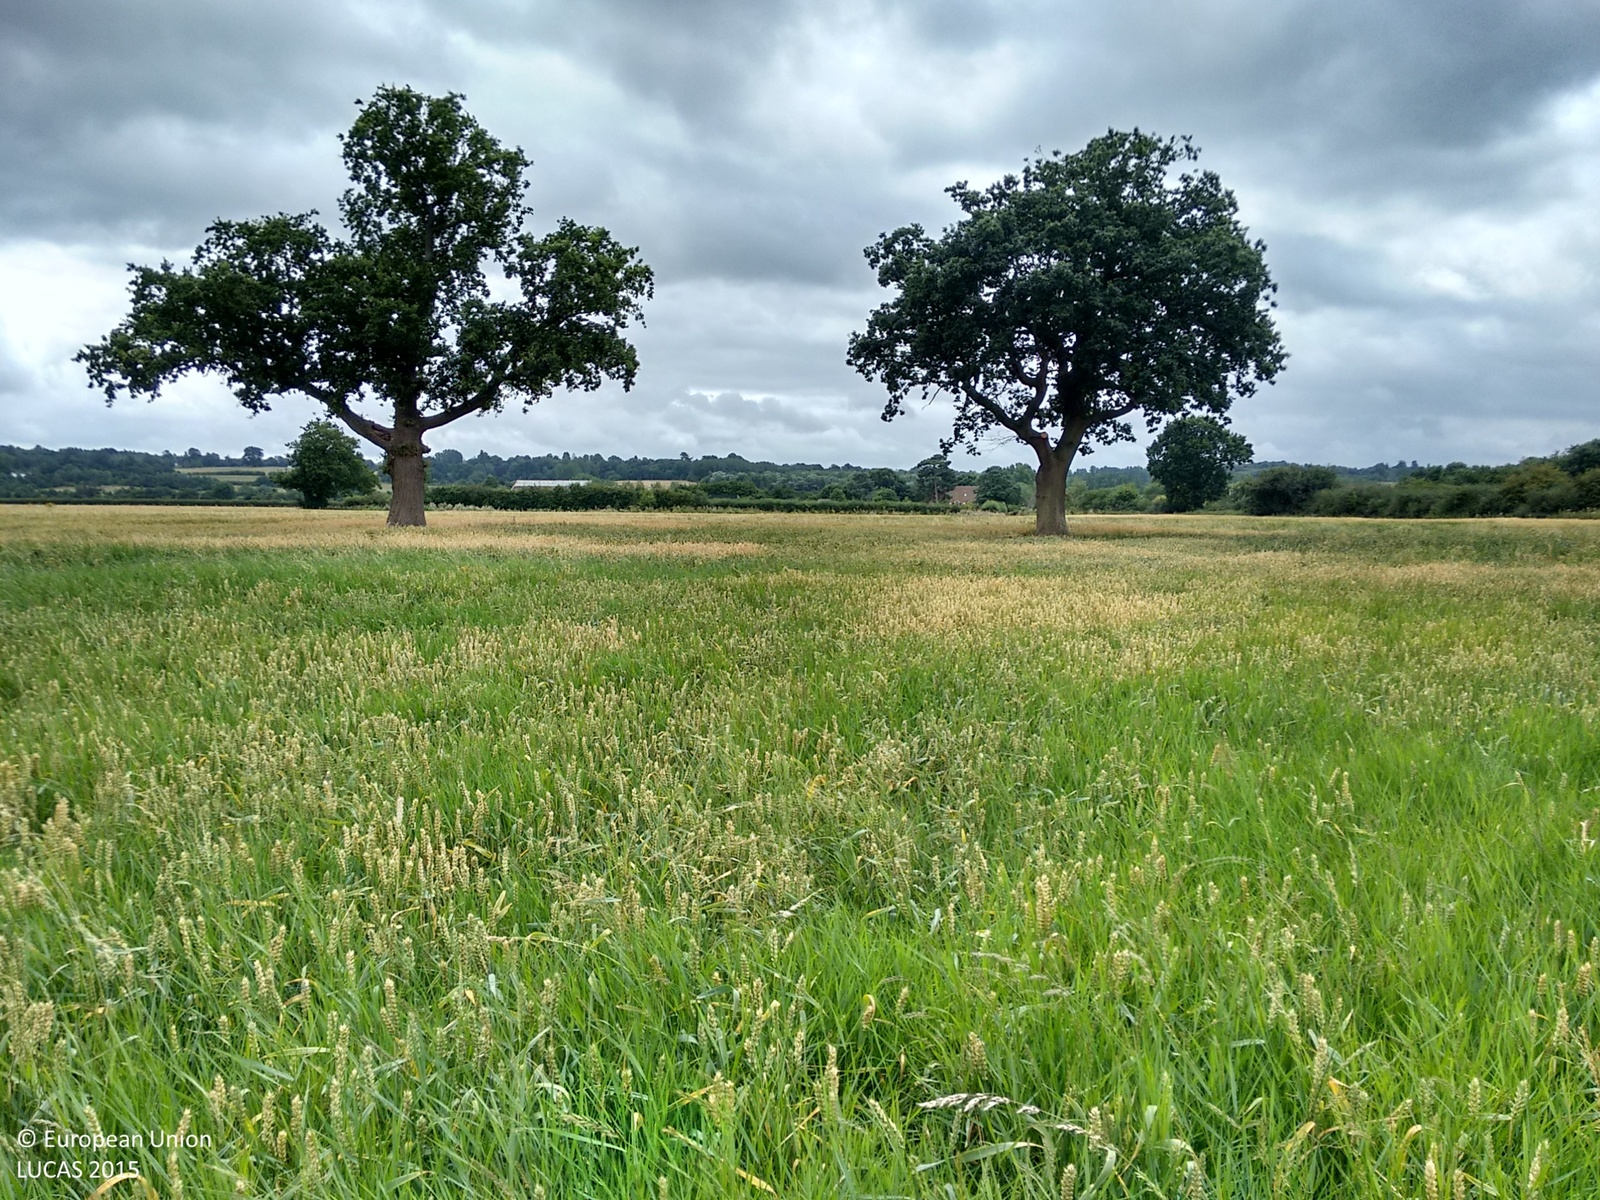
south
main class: Cropland
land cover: Mixed cereals for fodder
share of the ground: 50 - 75 %
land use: Agriculture (excluding fallow land and kitchen gardens)
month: August
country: GB
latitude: 51.2539
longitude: -0.1357
